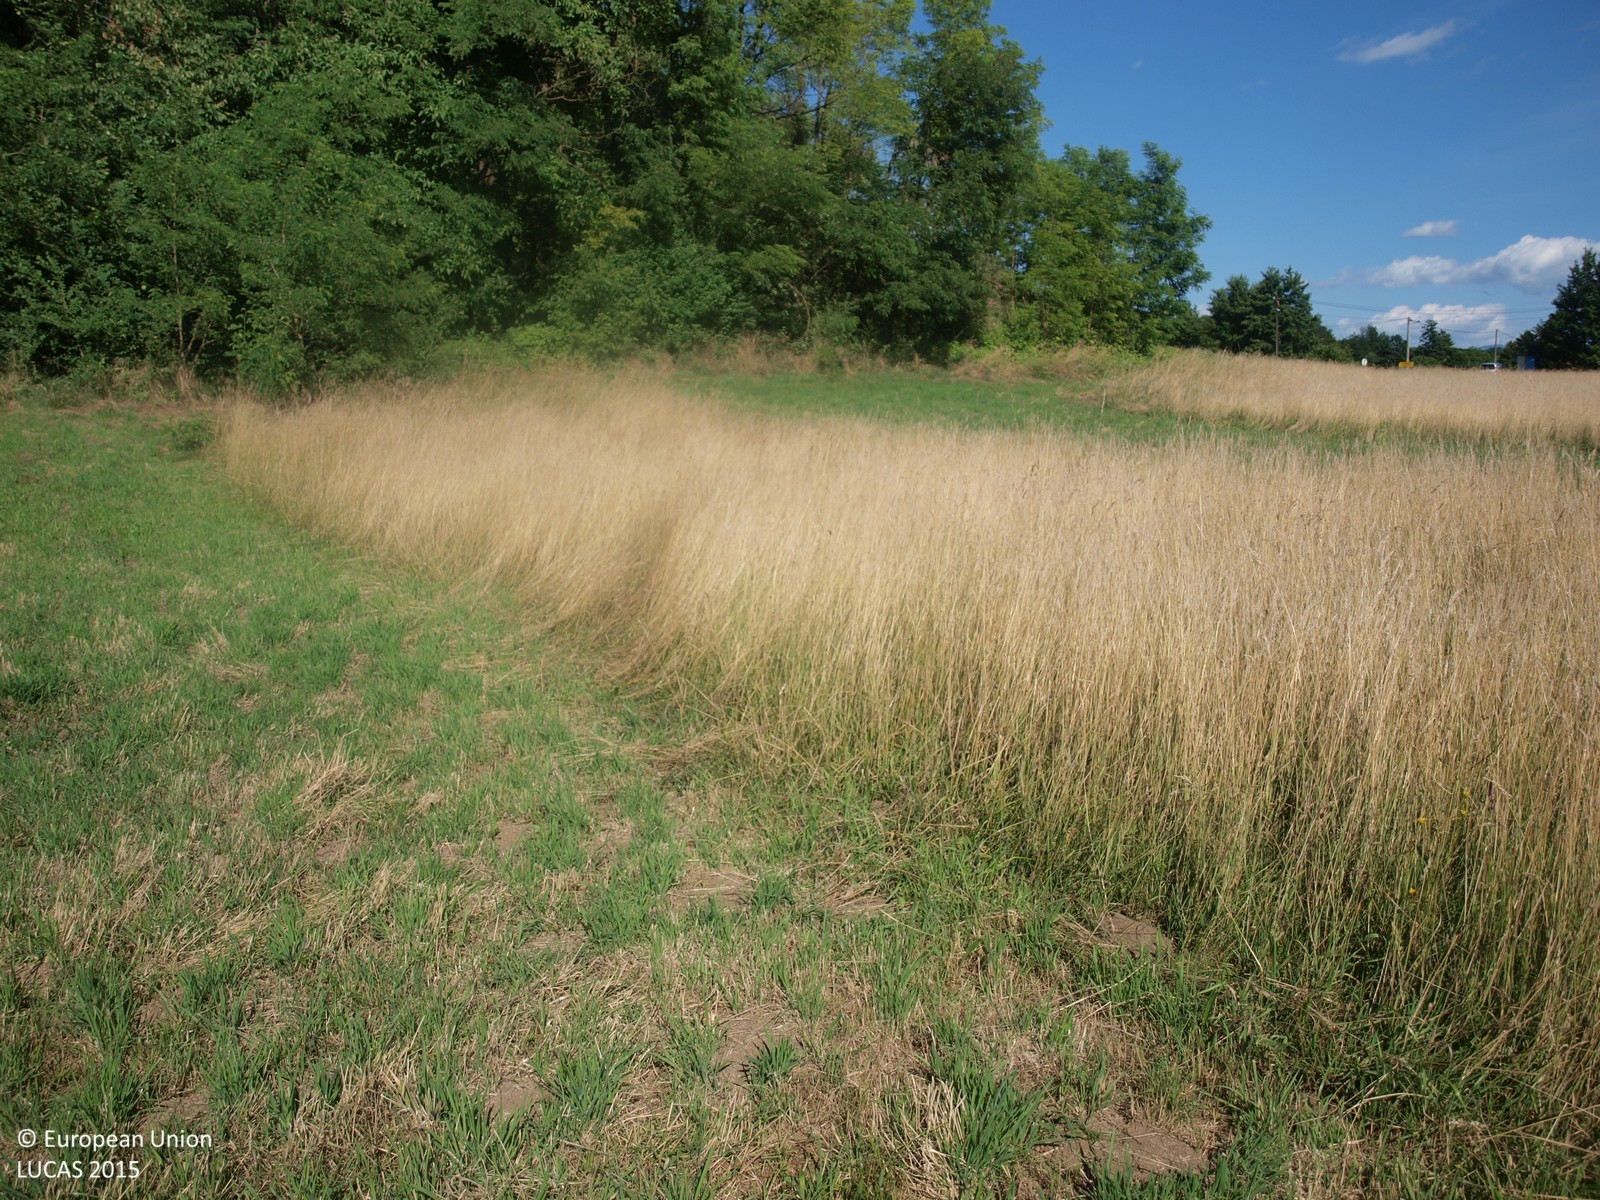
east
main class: Grassland
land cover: Grassland without tree/shrub cover
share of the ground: > 75 %
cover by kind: herbaceous plants 100 %
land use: Agriculture (excluding fallow land and kitchen gardens)
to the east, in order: Grassland without tree/shrub cover; Shrubland with sparse tree cover; Paved roads, cycling and walking lanes; Broadleaved woodland; Grassland without tree/shrub cover; Electric lines; Grassland without tree/shrub cover; Paved roads, cycling and walking lanes; Spontaneously vegetated surfaces; Maize; Broadleaved woodland
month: June
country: HR
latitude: 45.9996
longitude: 15.7180
